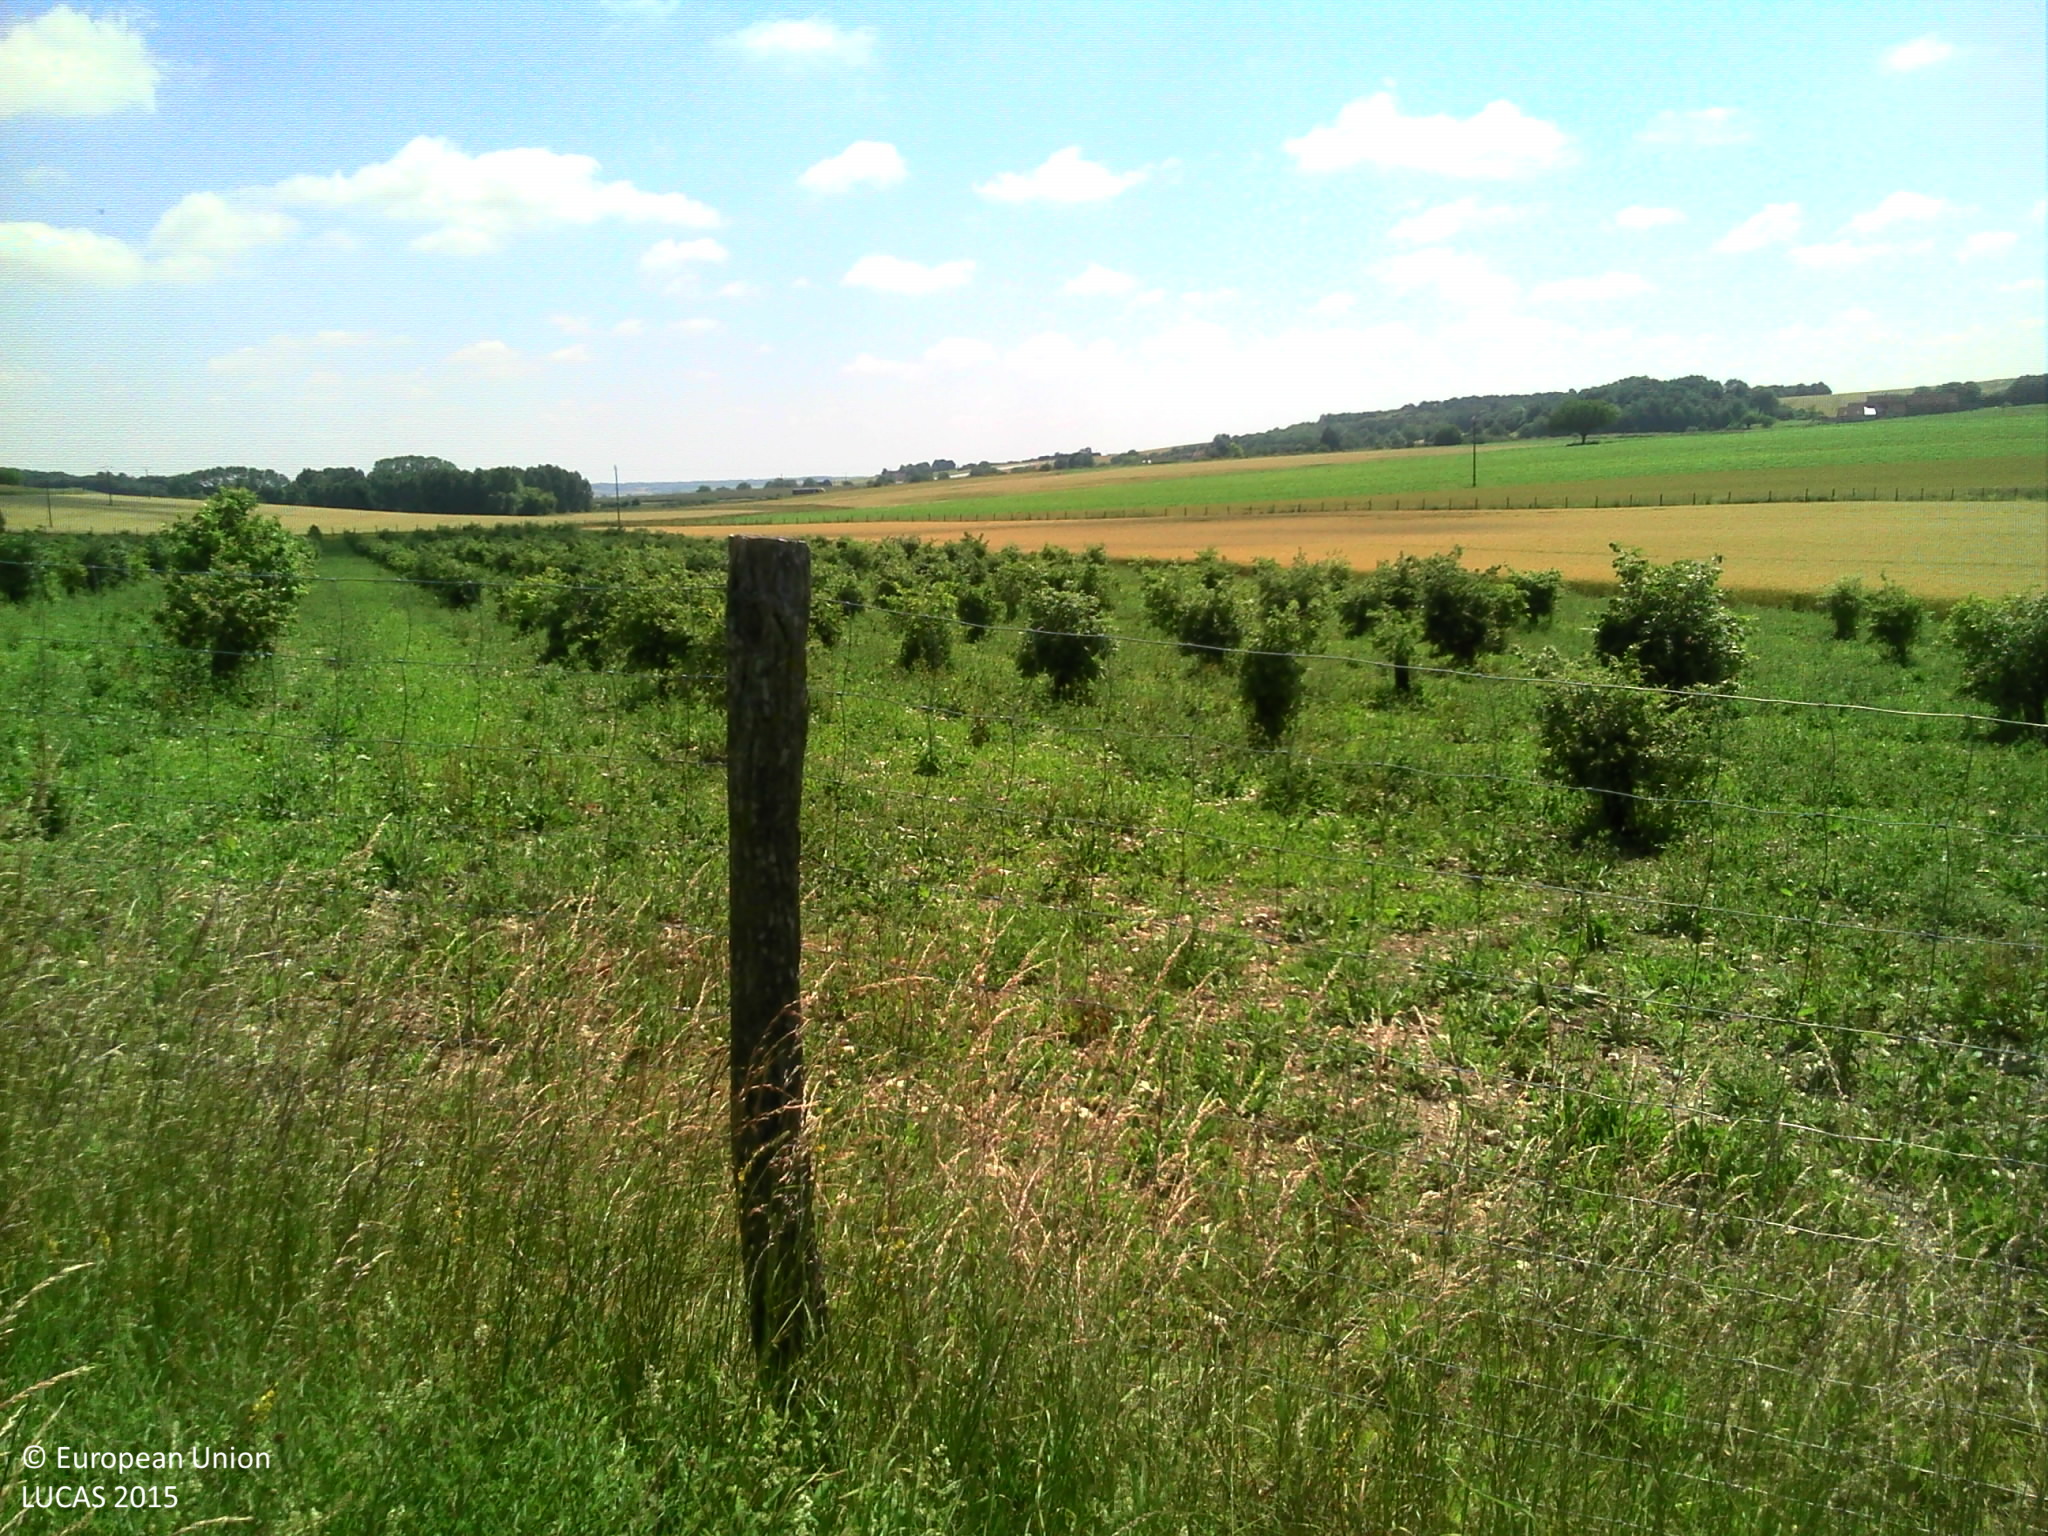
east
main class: Woodland
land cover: Broadleaved woodland
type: exotic forest
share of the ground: 25 - 50 %
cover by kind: herbaceous plants 65 %, broadleaved forest trees 25 %, unconsolidated bare surface 10 %
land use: Forestry
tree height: < 5 m
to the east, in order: Broadleaved woodland; Common wheat; Fences; Grassland without tree/shrub cover; Ditches and canals; Grassland without tree/shrub cover; Common wheat
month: June
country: FR
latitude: 46.9457
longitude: 0.5349
